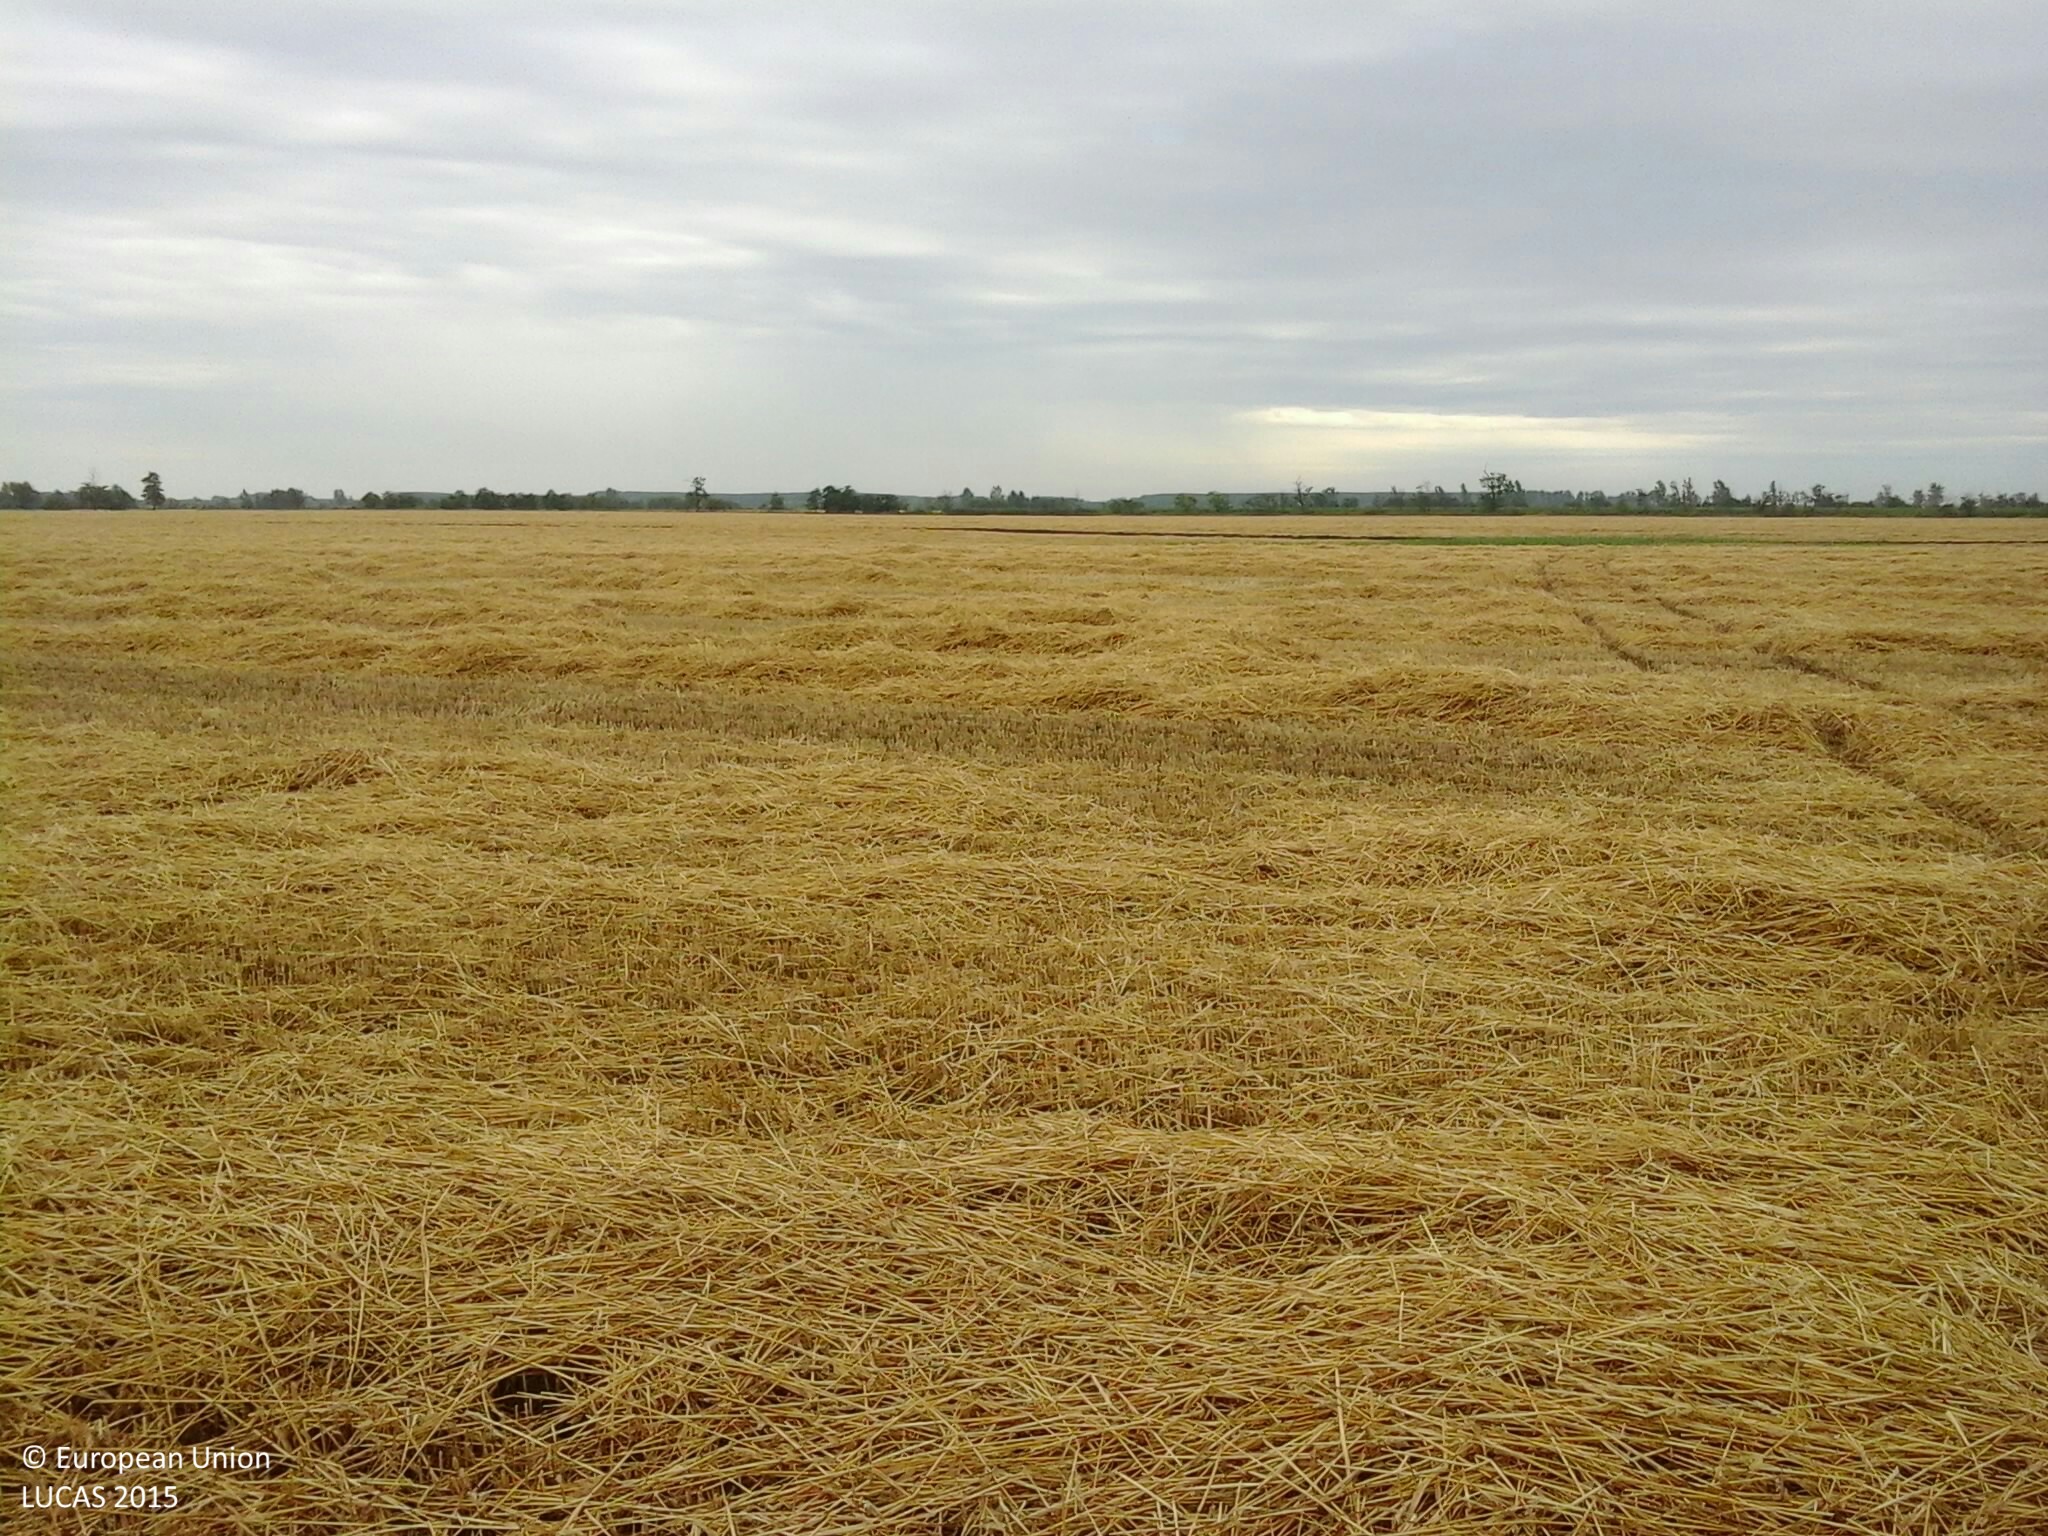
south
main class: Cropland
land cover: Common wheat
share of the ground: < 10 %
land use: Agriculture (excluding fallow land and kitchen gardens)
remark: Harvested field
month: July
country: HU
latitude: 46.9557
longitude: 20.3422
